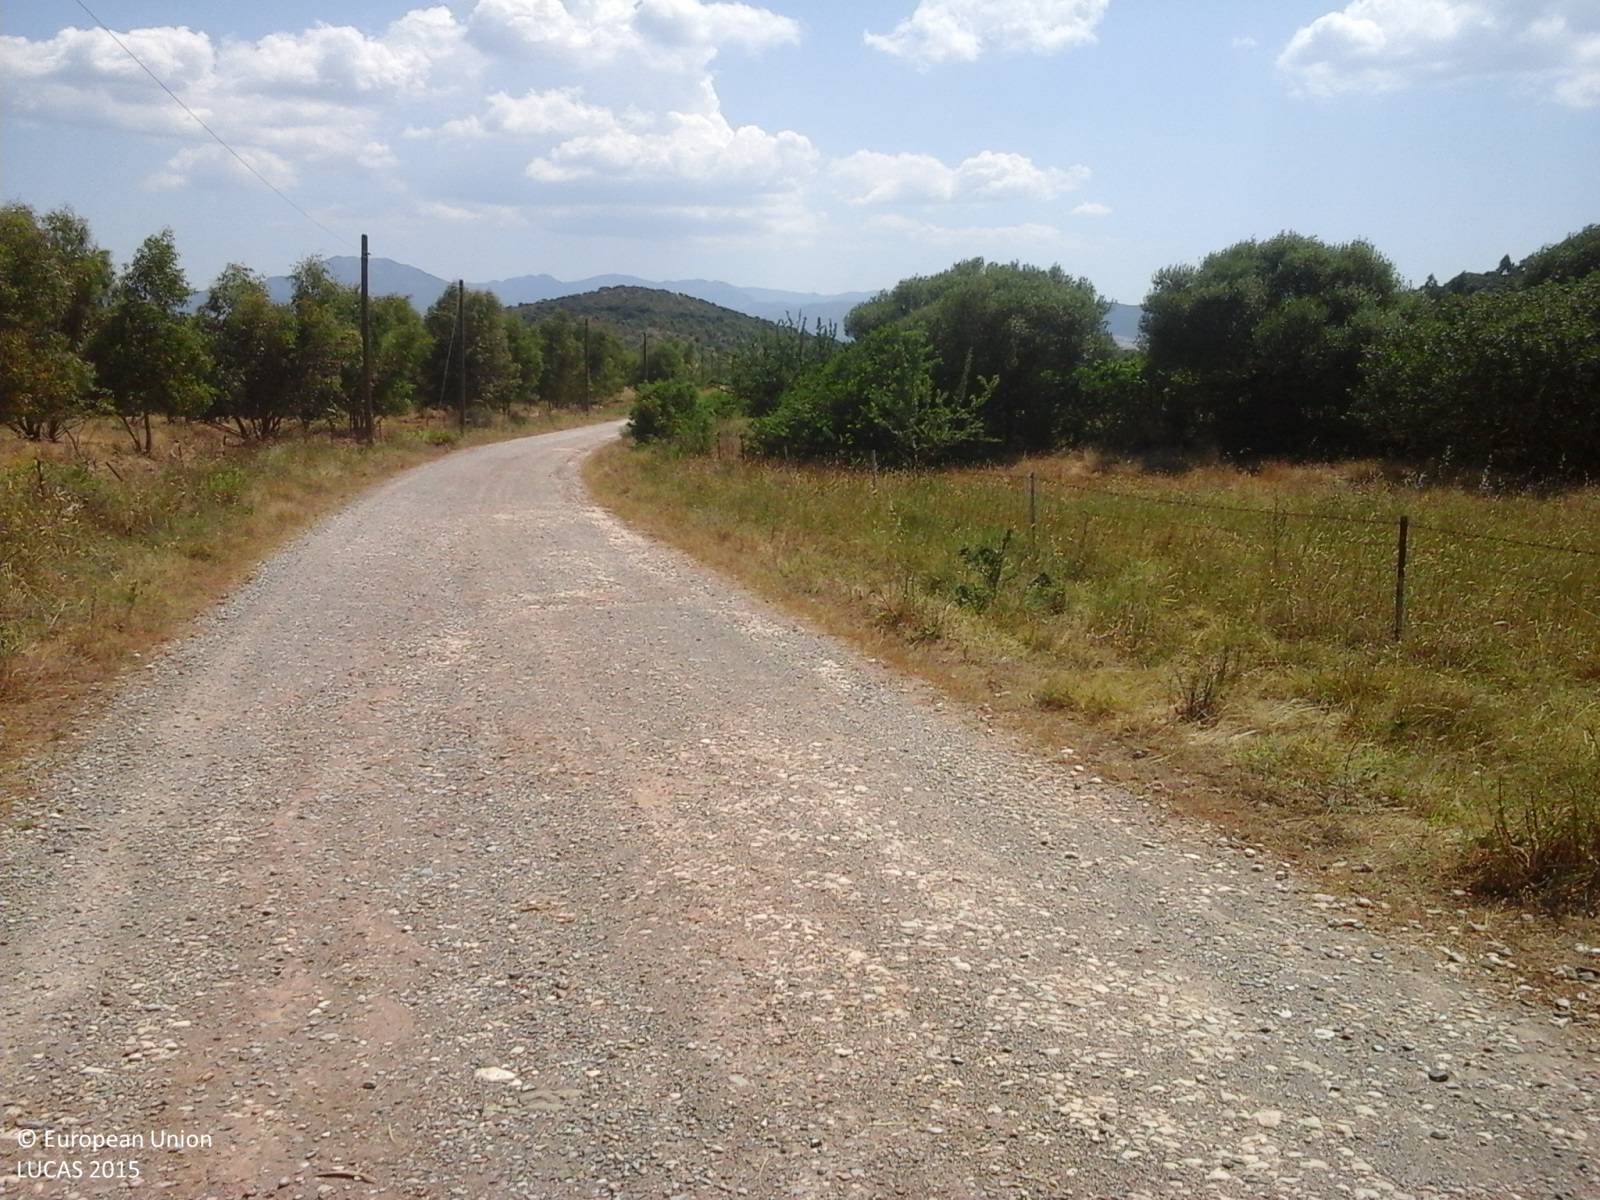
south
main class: Woodland
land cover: Broadleaved woodland
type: broadleaved evergreen forest
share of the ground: > 75 %
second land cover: Grassland without tree/shrub cover
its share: > 75 %
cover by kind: broadleaved forest trees 70 %, shrubs 20 %, herbaceous plants 10 %
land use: Forestry
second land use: Agriculture (excluding fallow land and kitchen gardens)
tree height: > 5 m
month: June
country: IT
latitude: 39.3186
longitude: 8.8356
